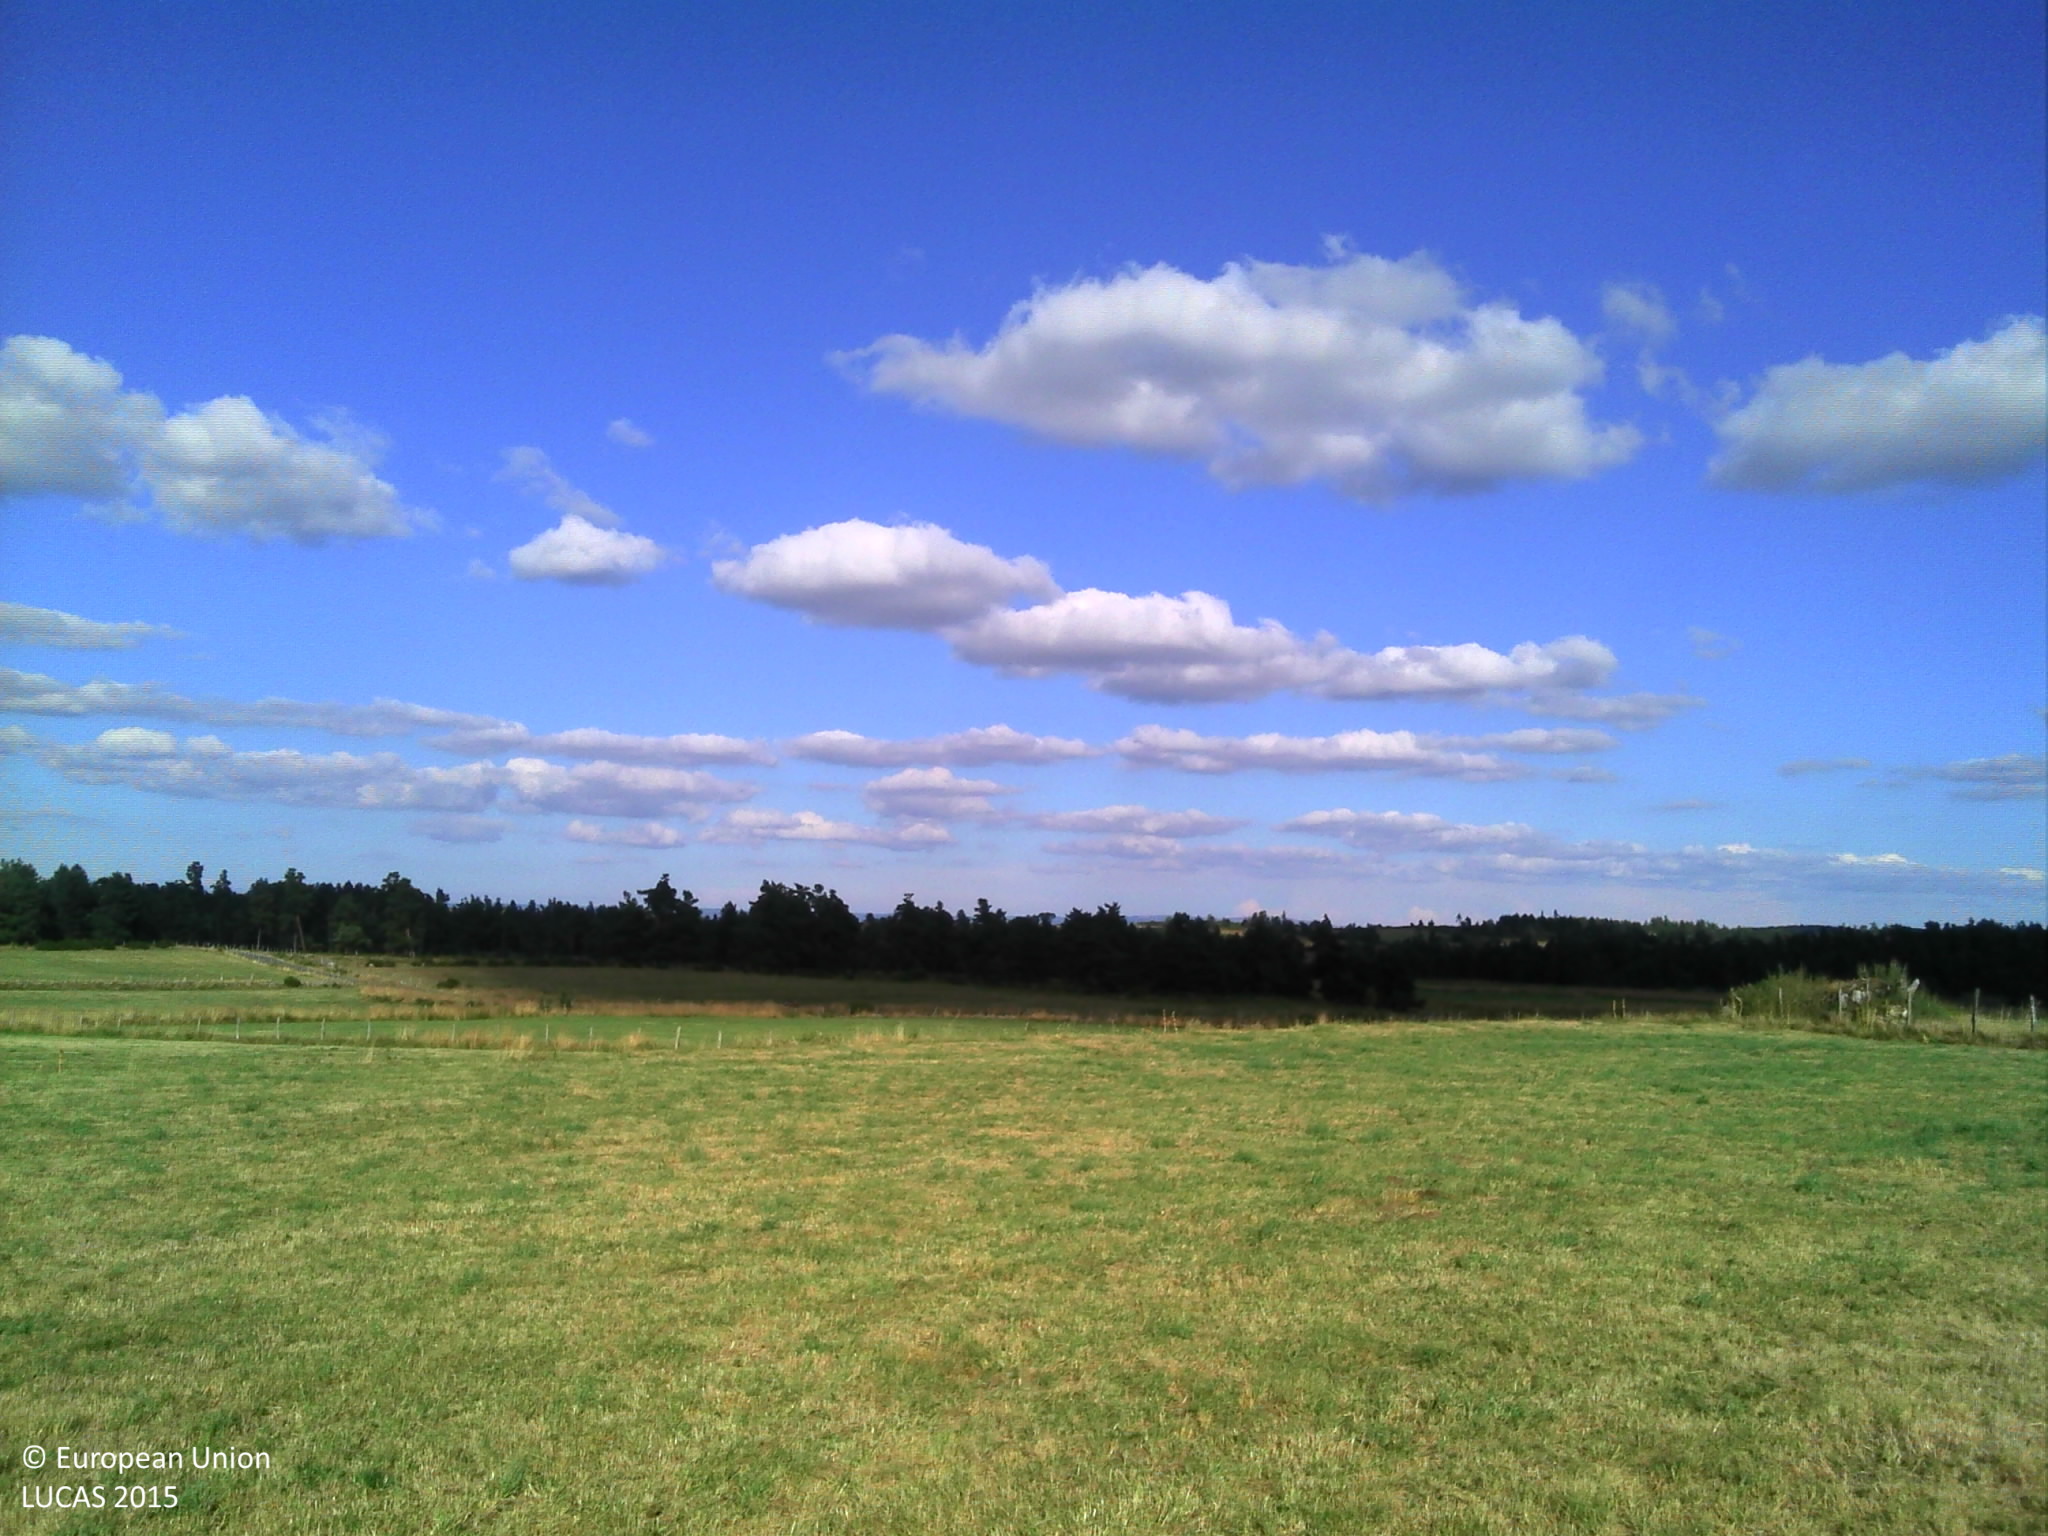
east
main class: Grassland
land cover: Grassland without tree/shrub cover
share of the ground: > 75 %
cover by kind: herbaceous plants 100 %
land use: Agriculture (excluding fallow land and kitchen gardens)
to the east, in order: Grassland without tree/shrub cover; Fences; Grassland without tree/shrub cover; Fences; Grassland without tree/shrub cover; Fences; Grassland without tree/shrub cover; Rivers and streams; Fences; Paved roads, cycling and walking lanes; Ditches and canals; Shrubland without tree cover; Fences; Grassland without tree/shrub cover
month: July
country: FR
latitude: 44.7227
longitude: 3.1735
